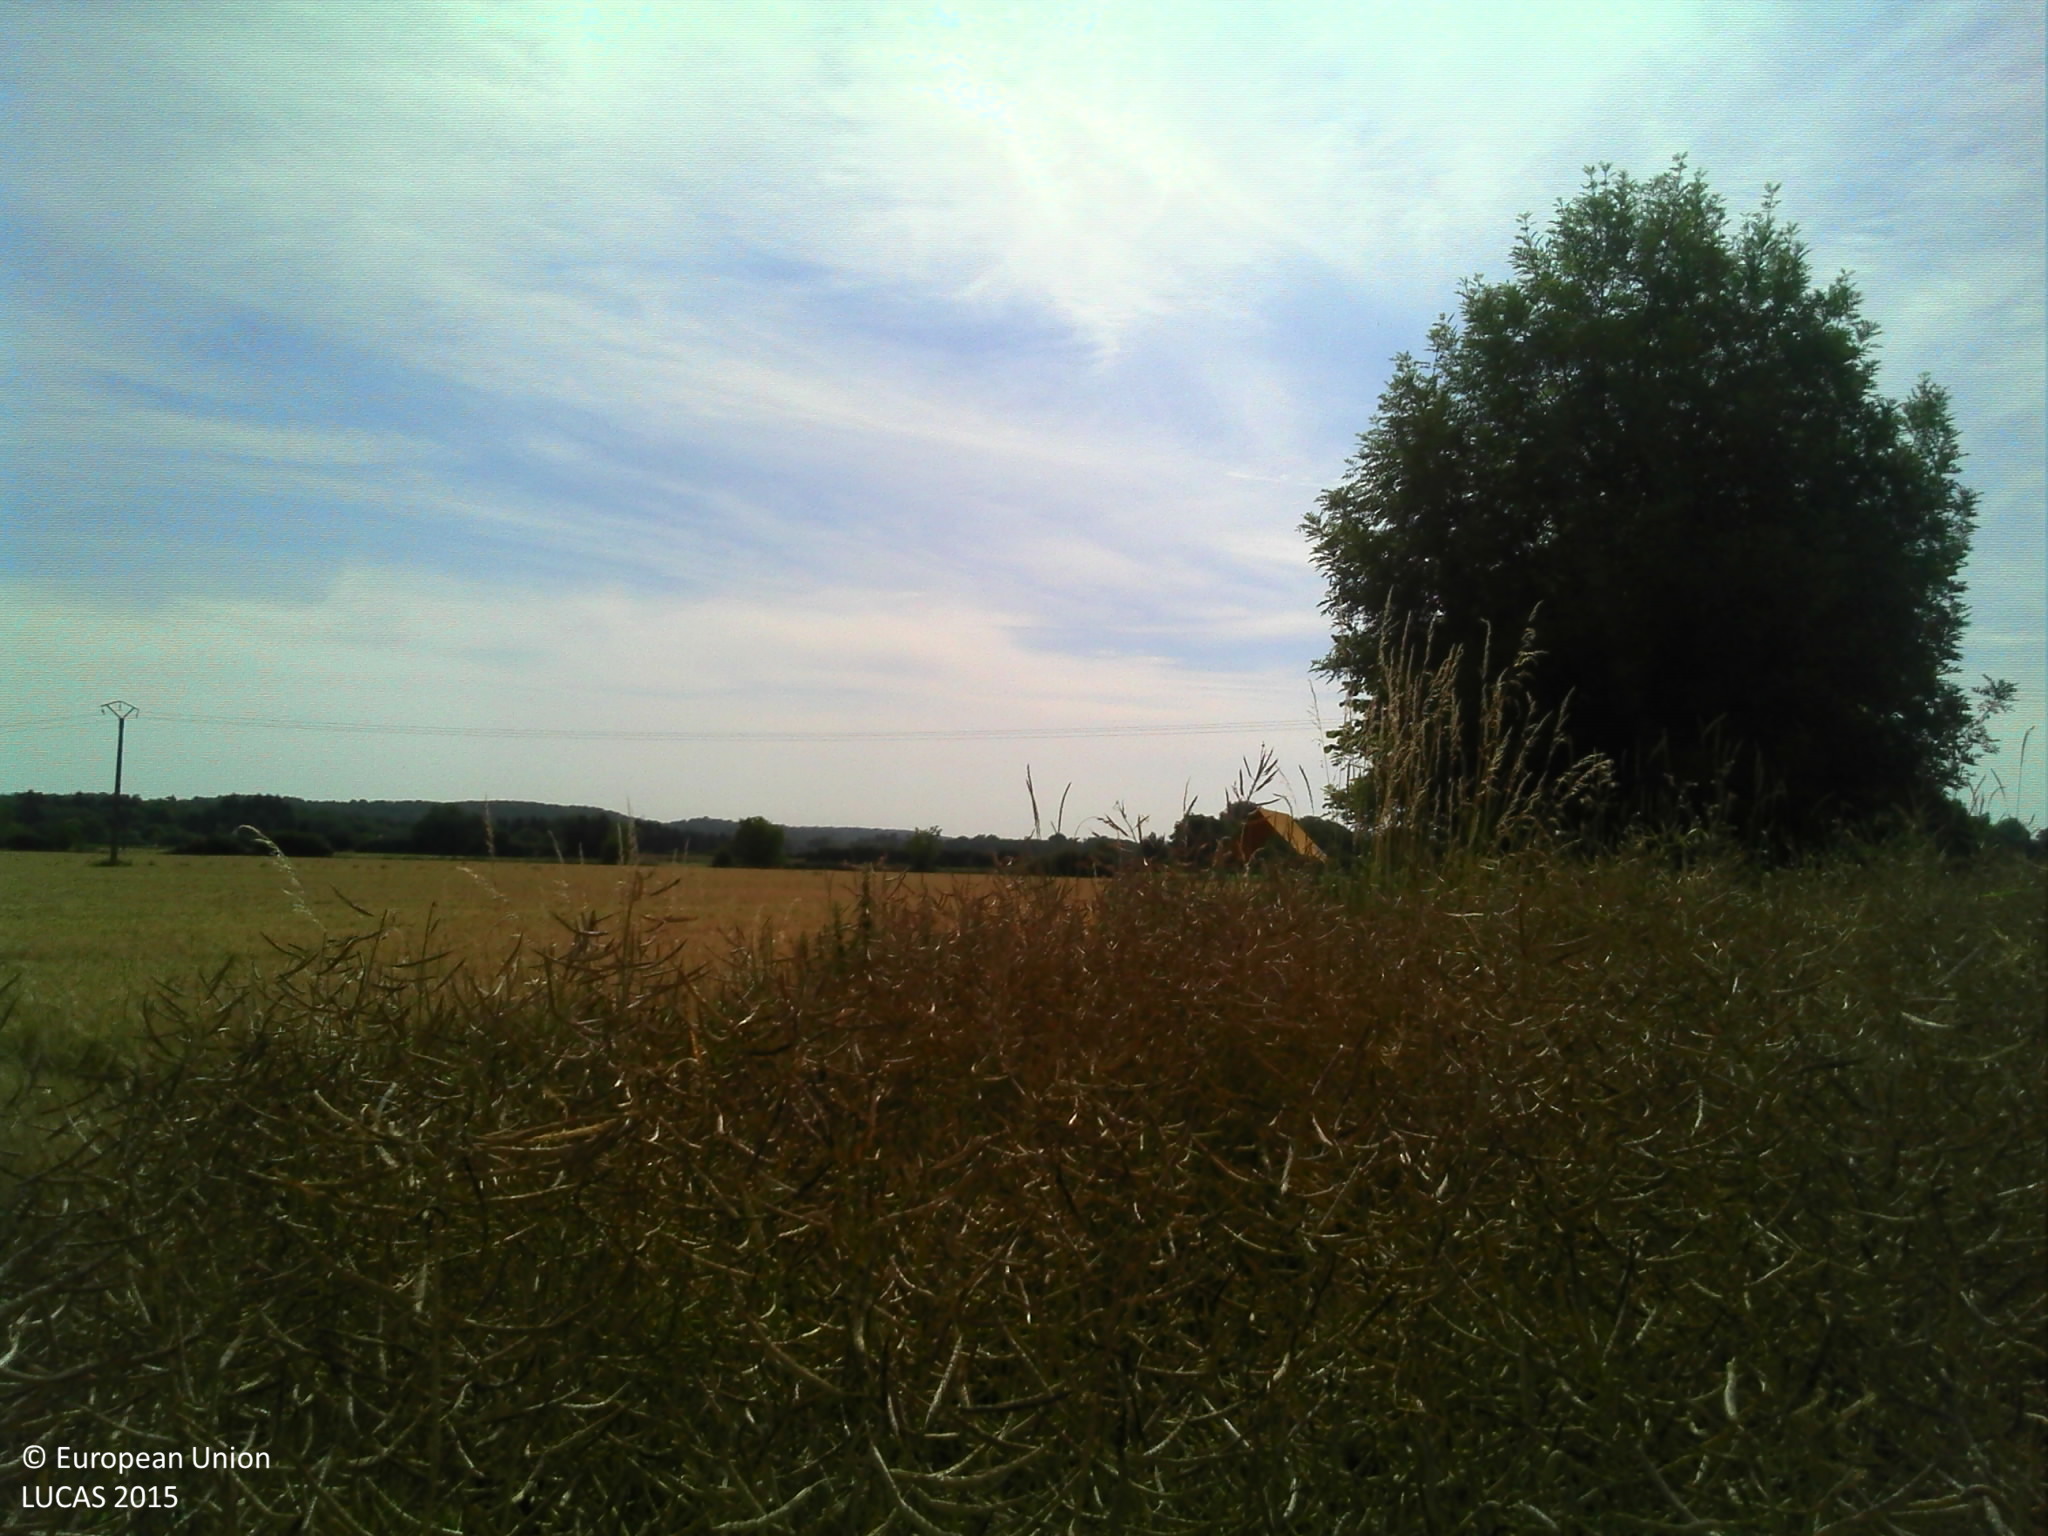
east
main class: Cropland
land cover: Rape and turnip rape
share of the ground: > 75 %
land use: Agriculture (excluding fallow land and kitchen gardens)
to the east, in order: Rape and turnip rape; Abandoned hedges; Triticale; Electric lines; Triticale; Abandoned hedges; Maize
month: June
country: FR
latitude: 47.6693
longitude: 2.6273
